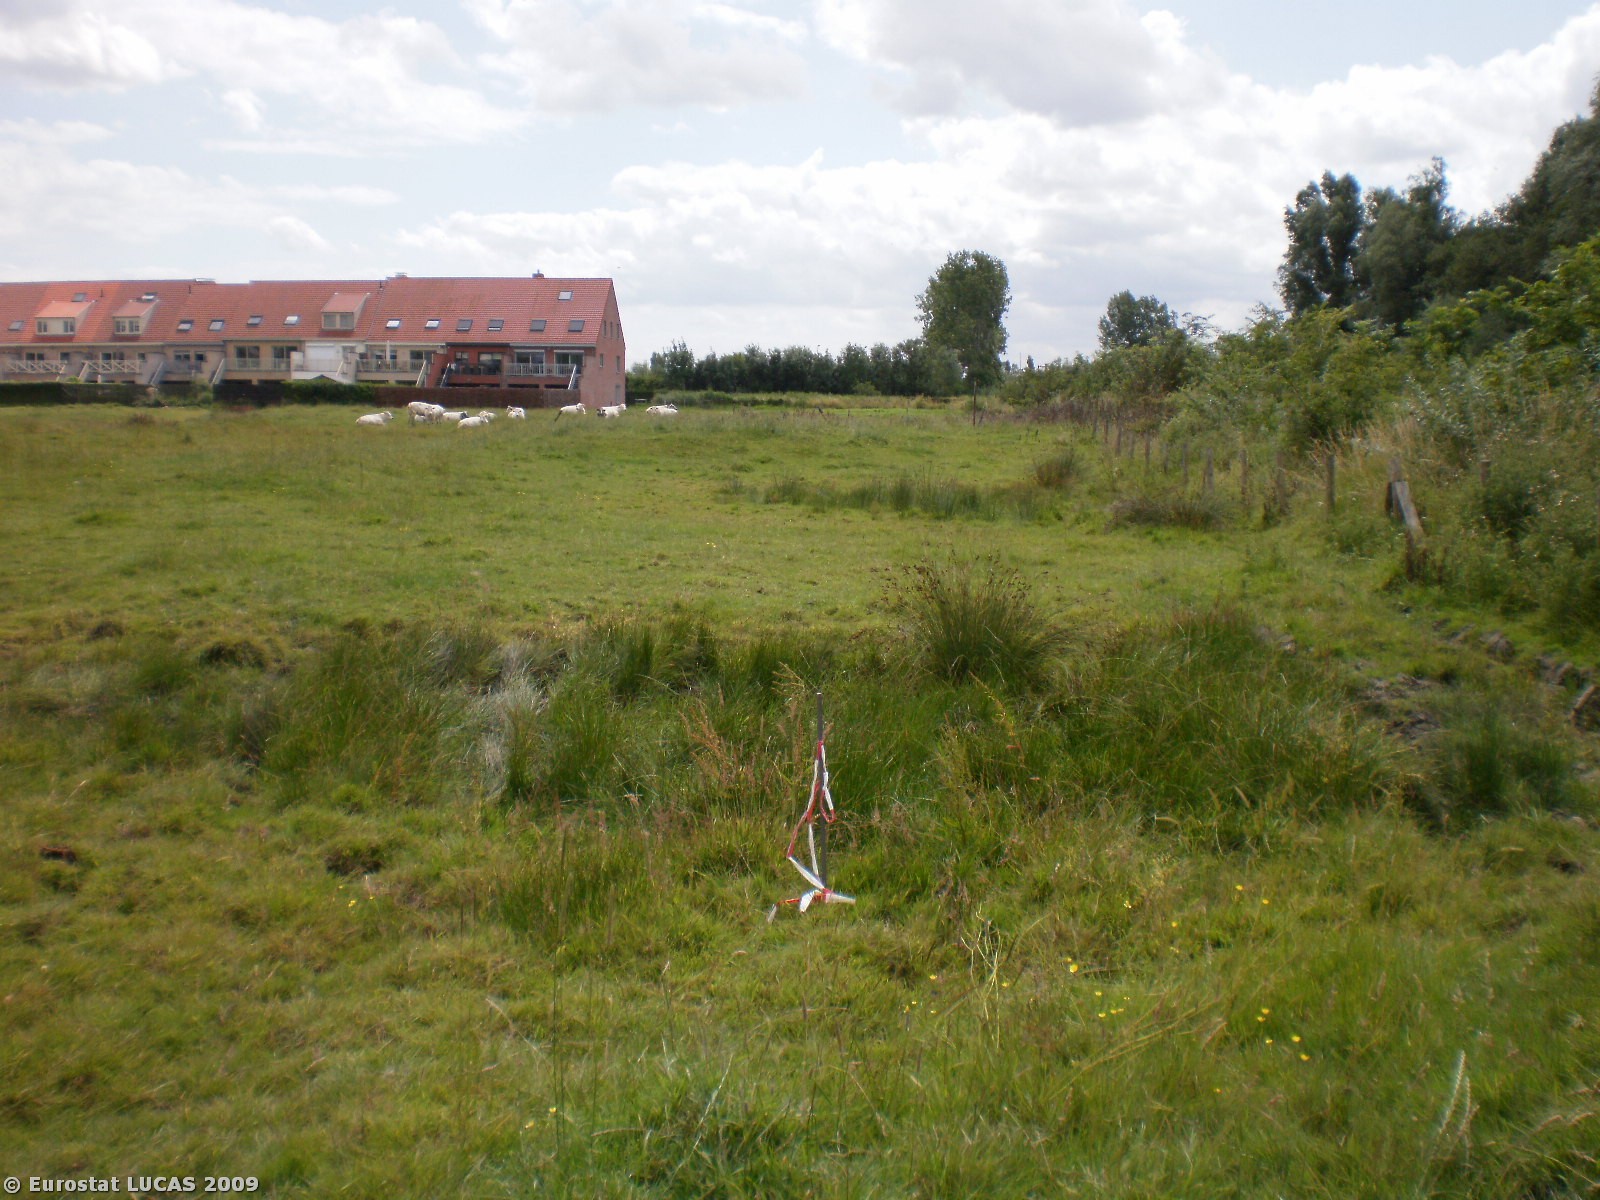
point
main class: Grassland
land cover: Grassland without tree/shrub cover
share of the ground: > 75 %
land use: Agriculture (excluding fallow land and kitchen gardens)
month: July
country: BE
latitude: 51.3363
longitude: 3.2302
